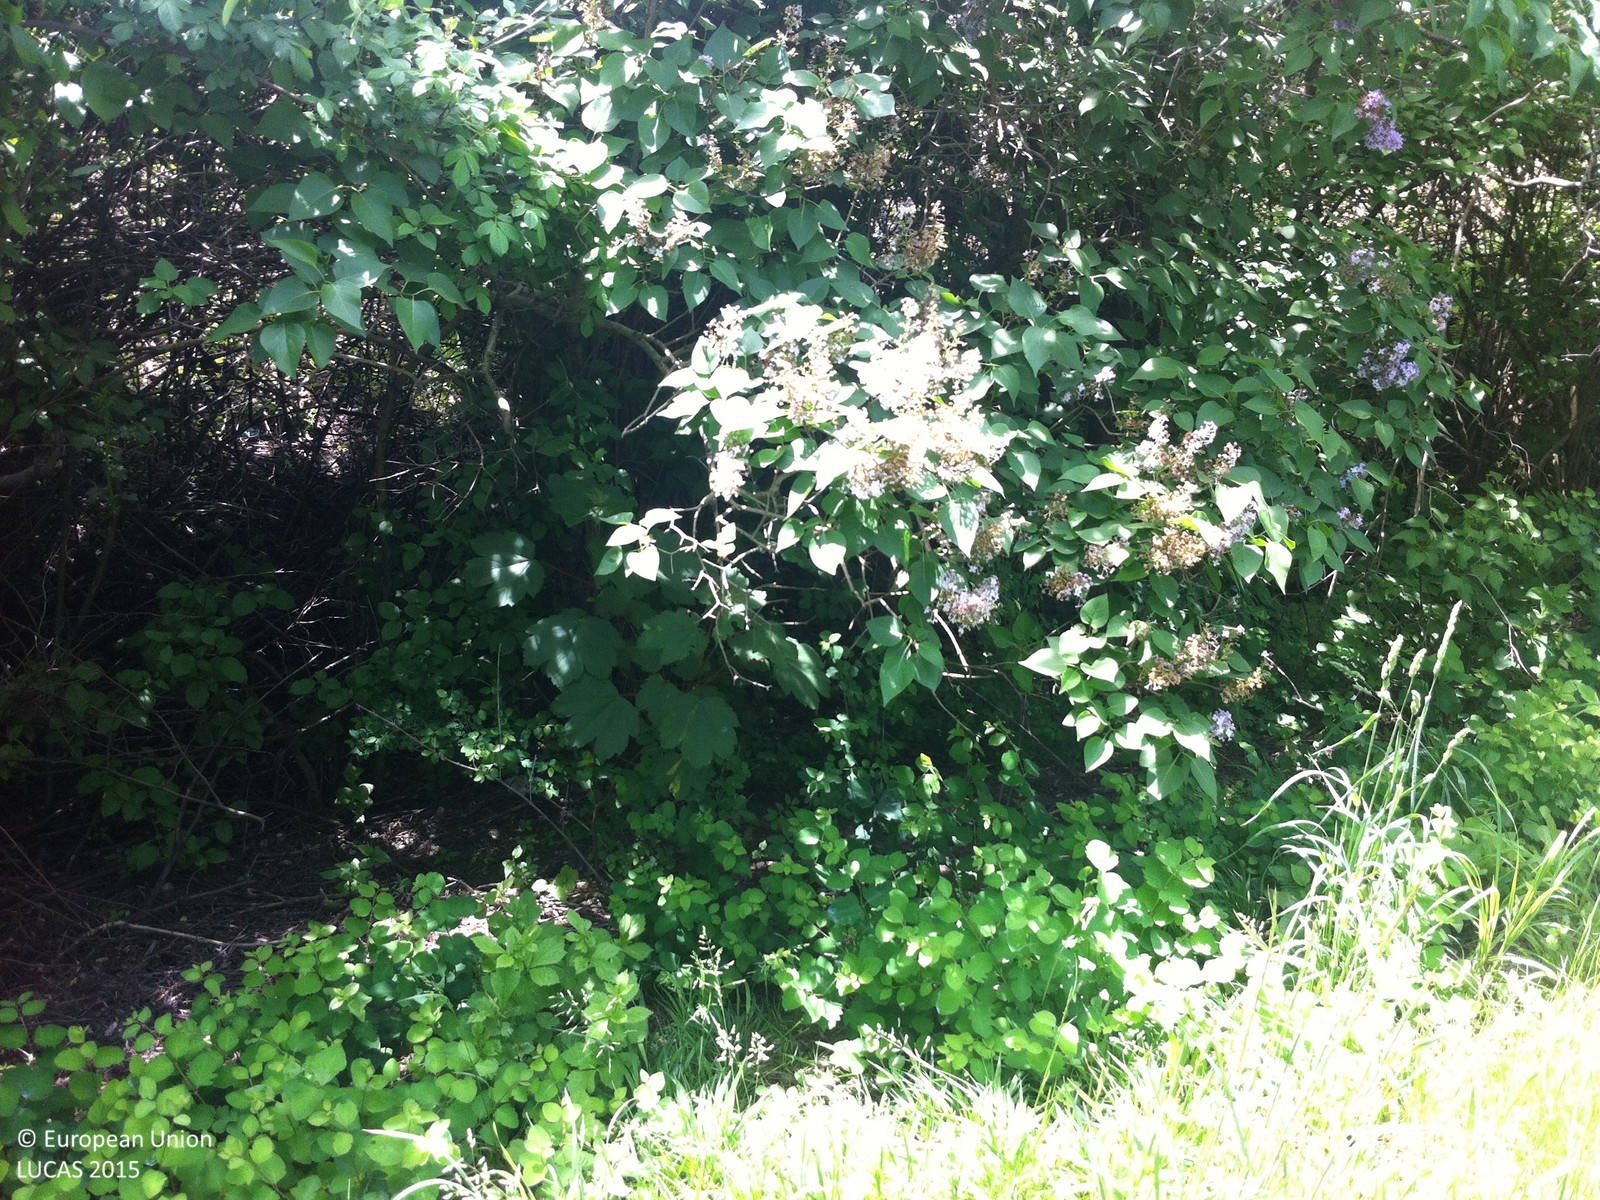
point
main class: Woodland
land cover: Broadleaved woodland
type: mesophytic deciduous forest
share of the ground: > 75 %
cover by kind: broadleaved forest trees 100 %
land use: Semi-natural and natural areas not in use
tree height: > 5 m
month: May
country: AT
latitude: 47.2614
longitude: 11.3336
